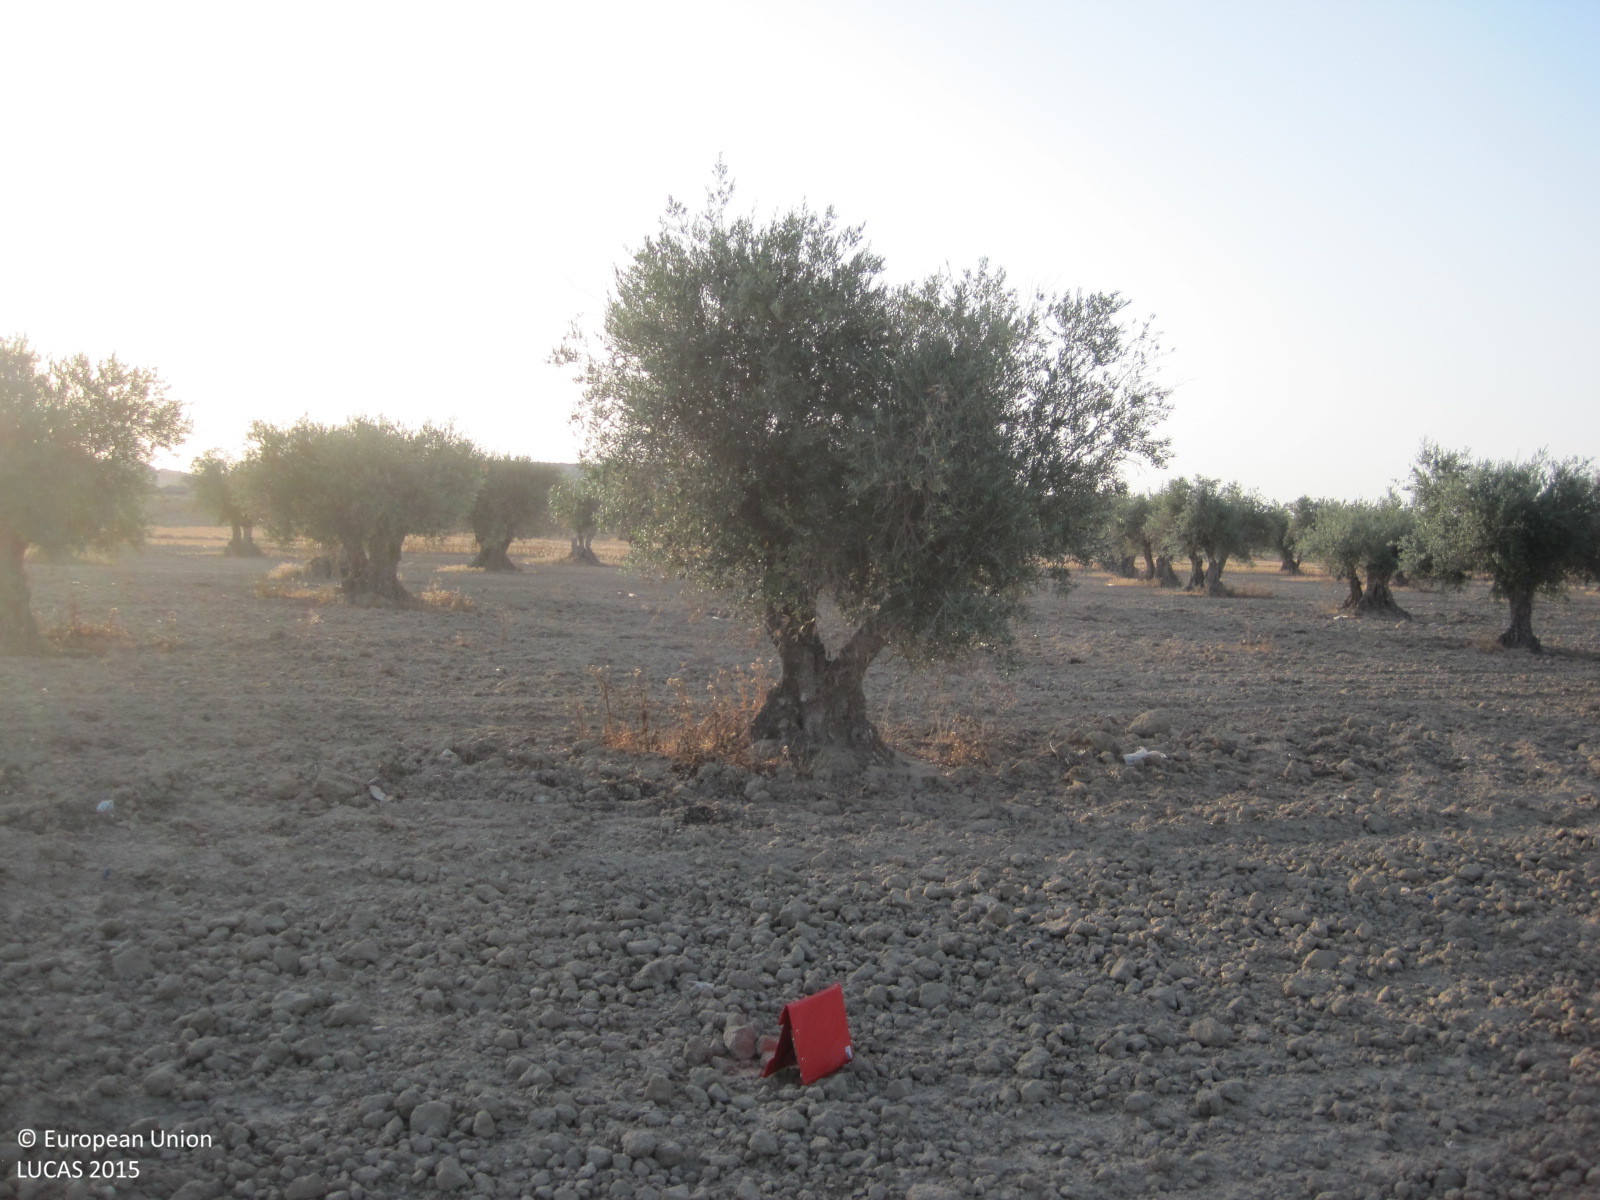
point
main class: Cropland
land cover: Olive groves
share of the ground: 50 - 75 %
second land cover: Other bare soil
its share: > 75 %
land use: Agriculture (excluding fallow land and kitchen gardens)
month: July
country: ES
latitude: 39.9988
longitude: -3.8198
